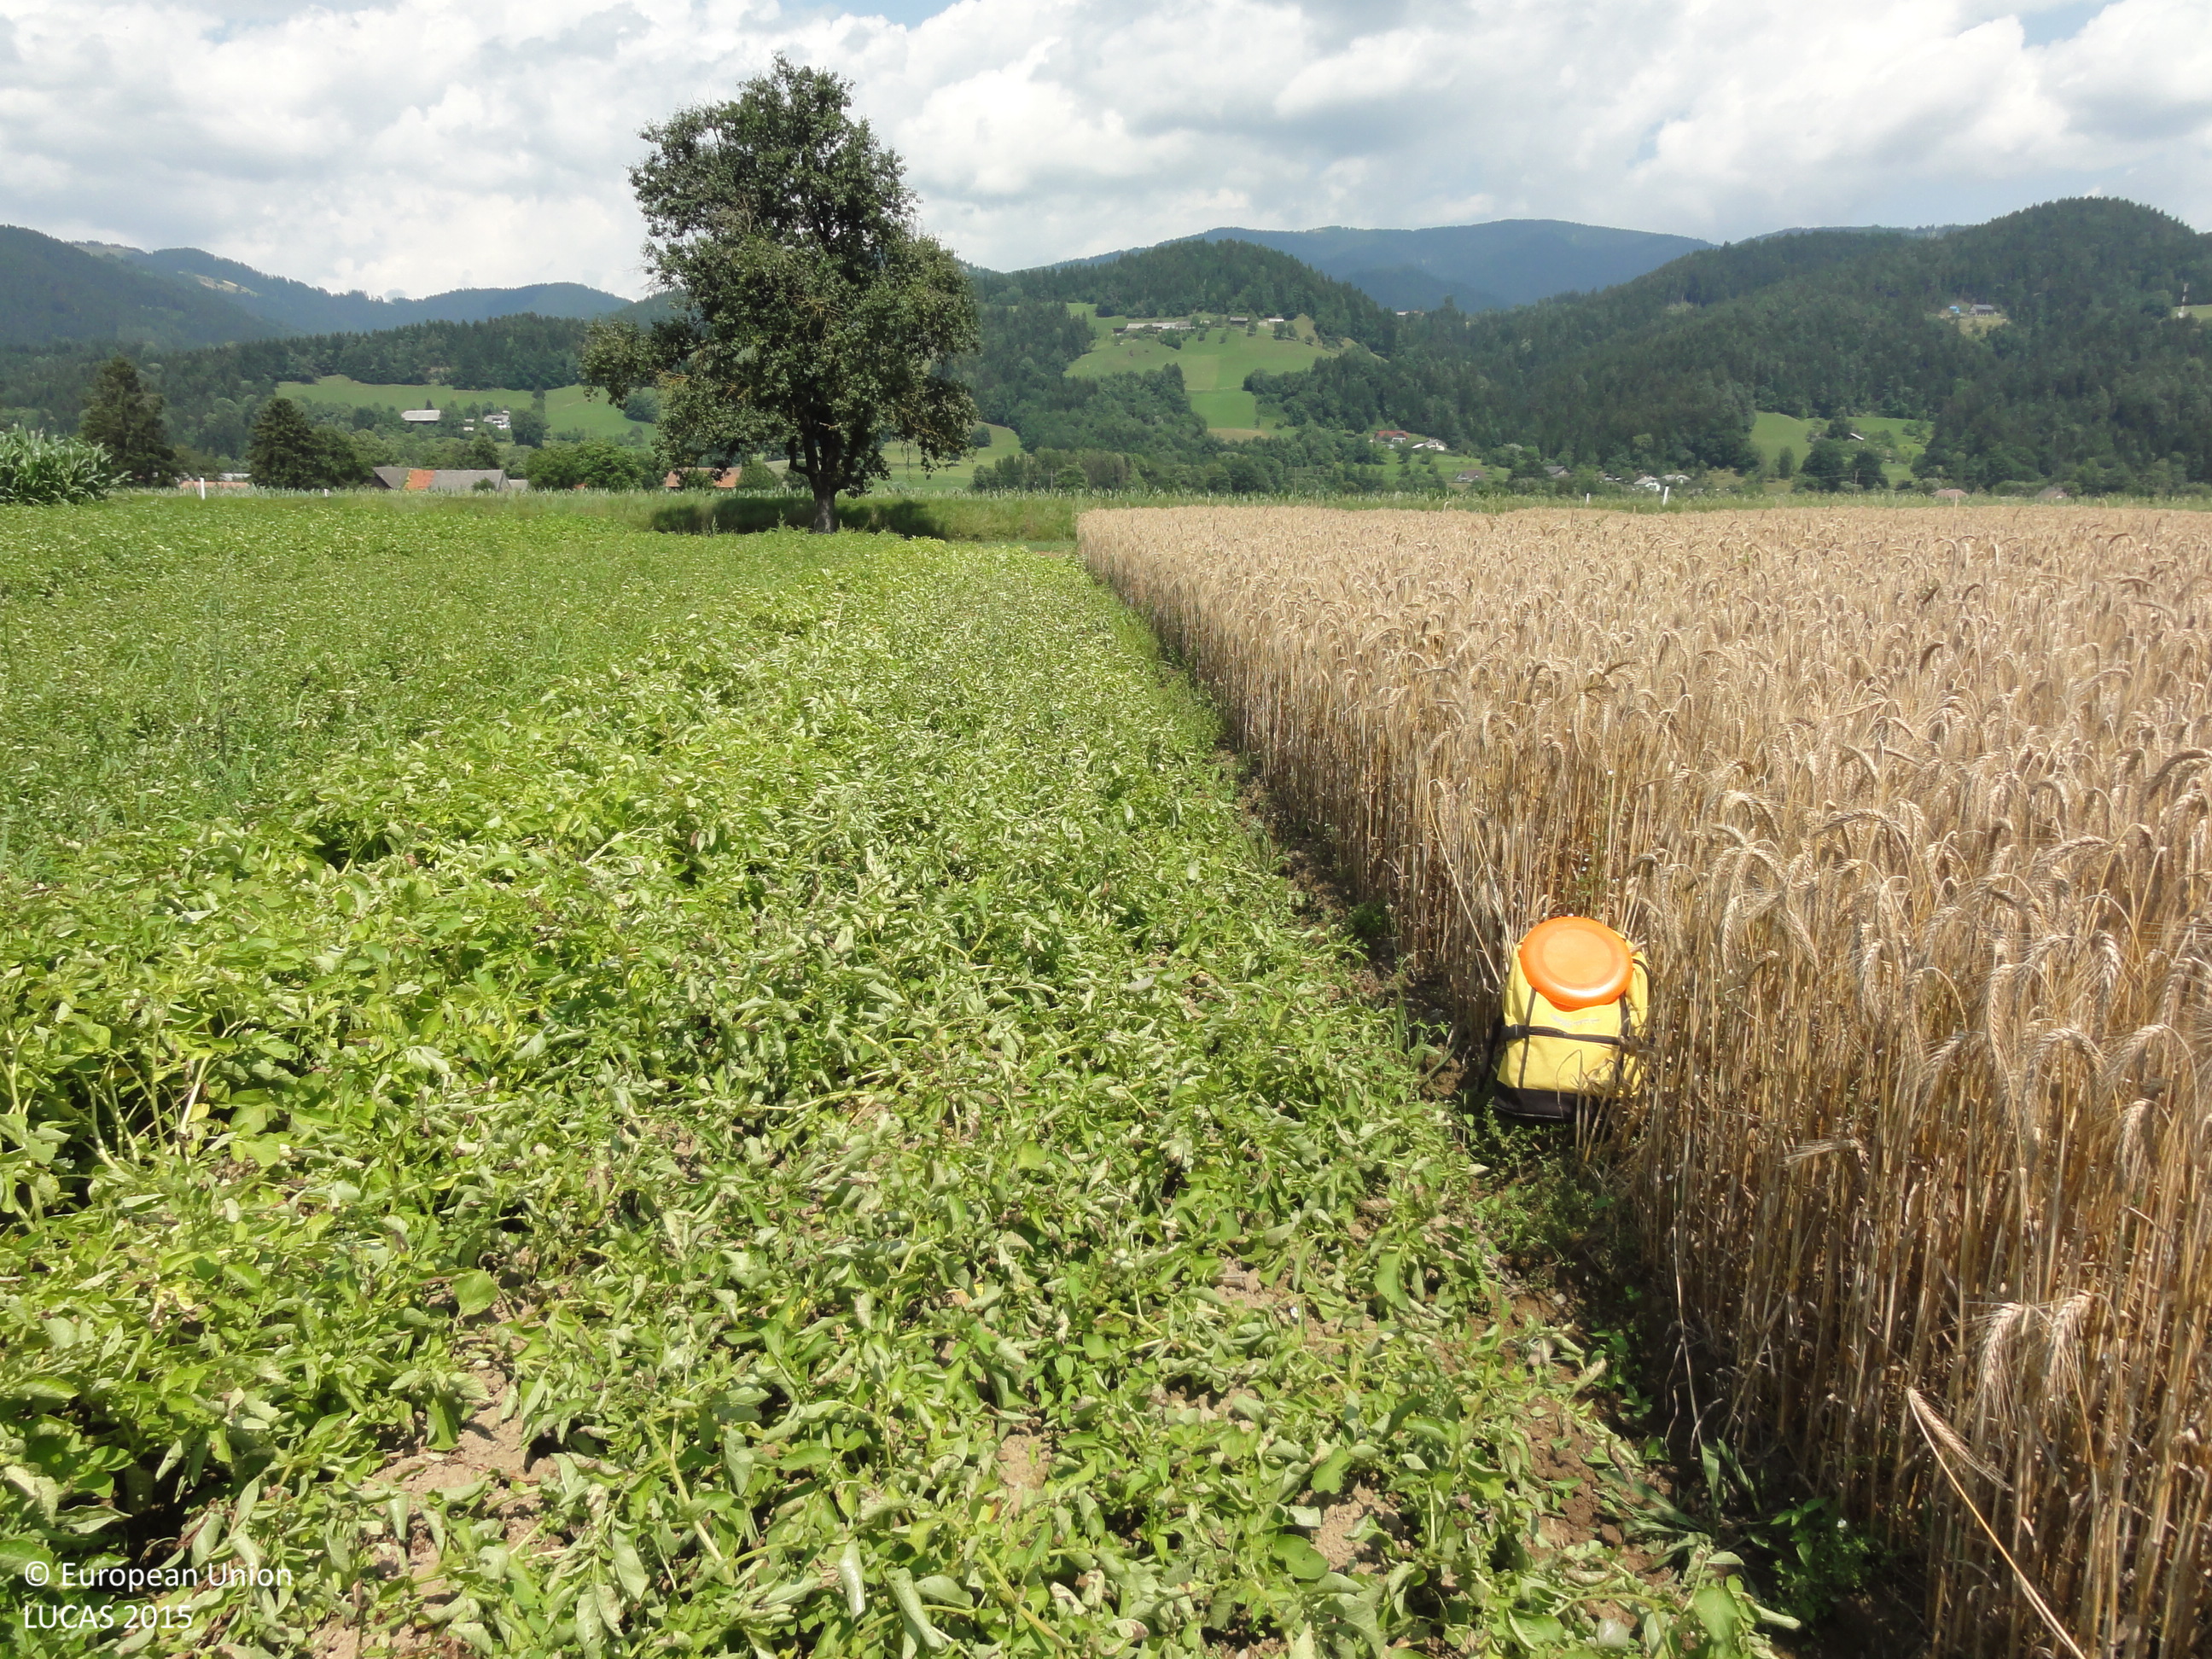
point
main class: Cropland
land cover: Common wheat
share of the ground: > 75 %
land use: Agriculture (excluding fallow land and kitchen gardens)
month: July
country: SI
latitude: 46.4814
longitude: 15.1172
